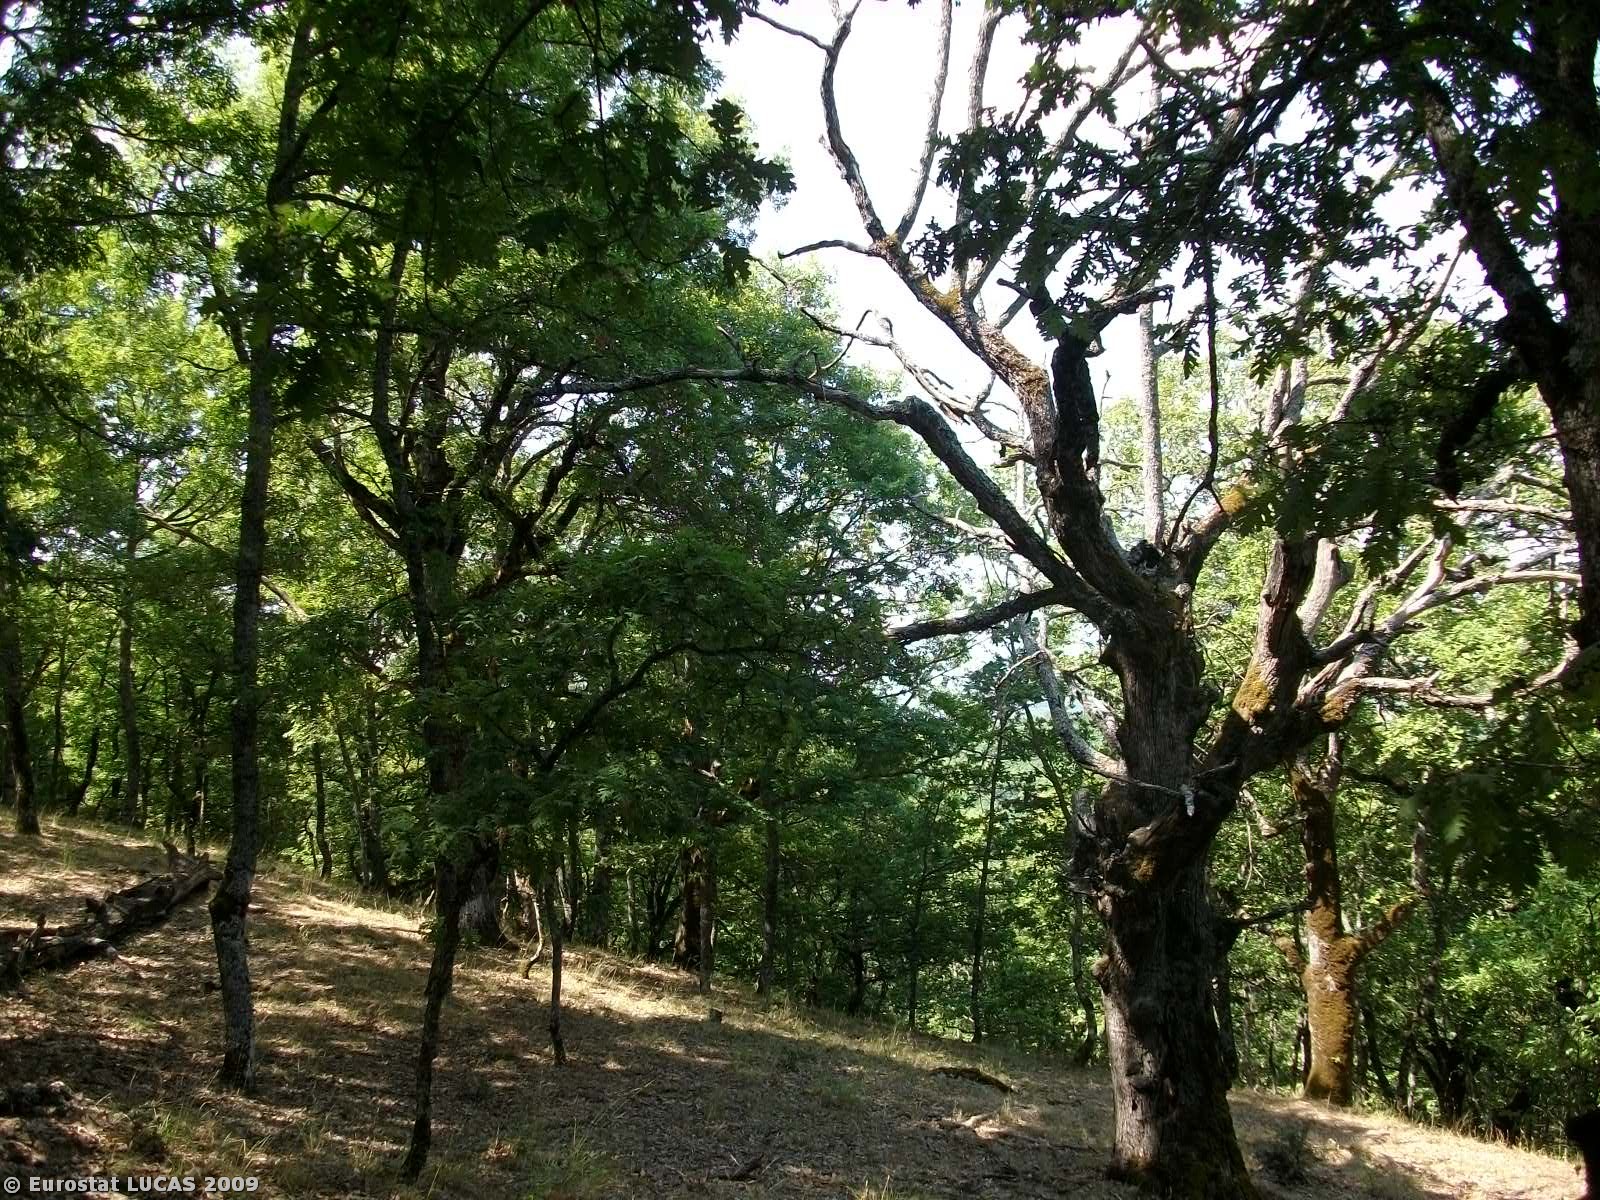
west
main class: Woodland
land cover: Broadleaved woodland
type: thermophilous deciduous forest
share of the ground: > 75 %
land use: Forestry
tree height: > 5 m
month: July
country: GR
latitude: 39.7898
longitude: 21.6510
